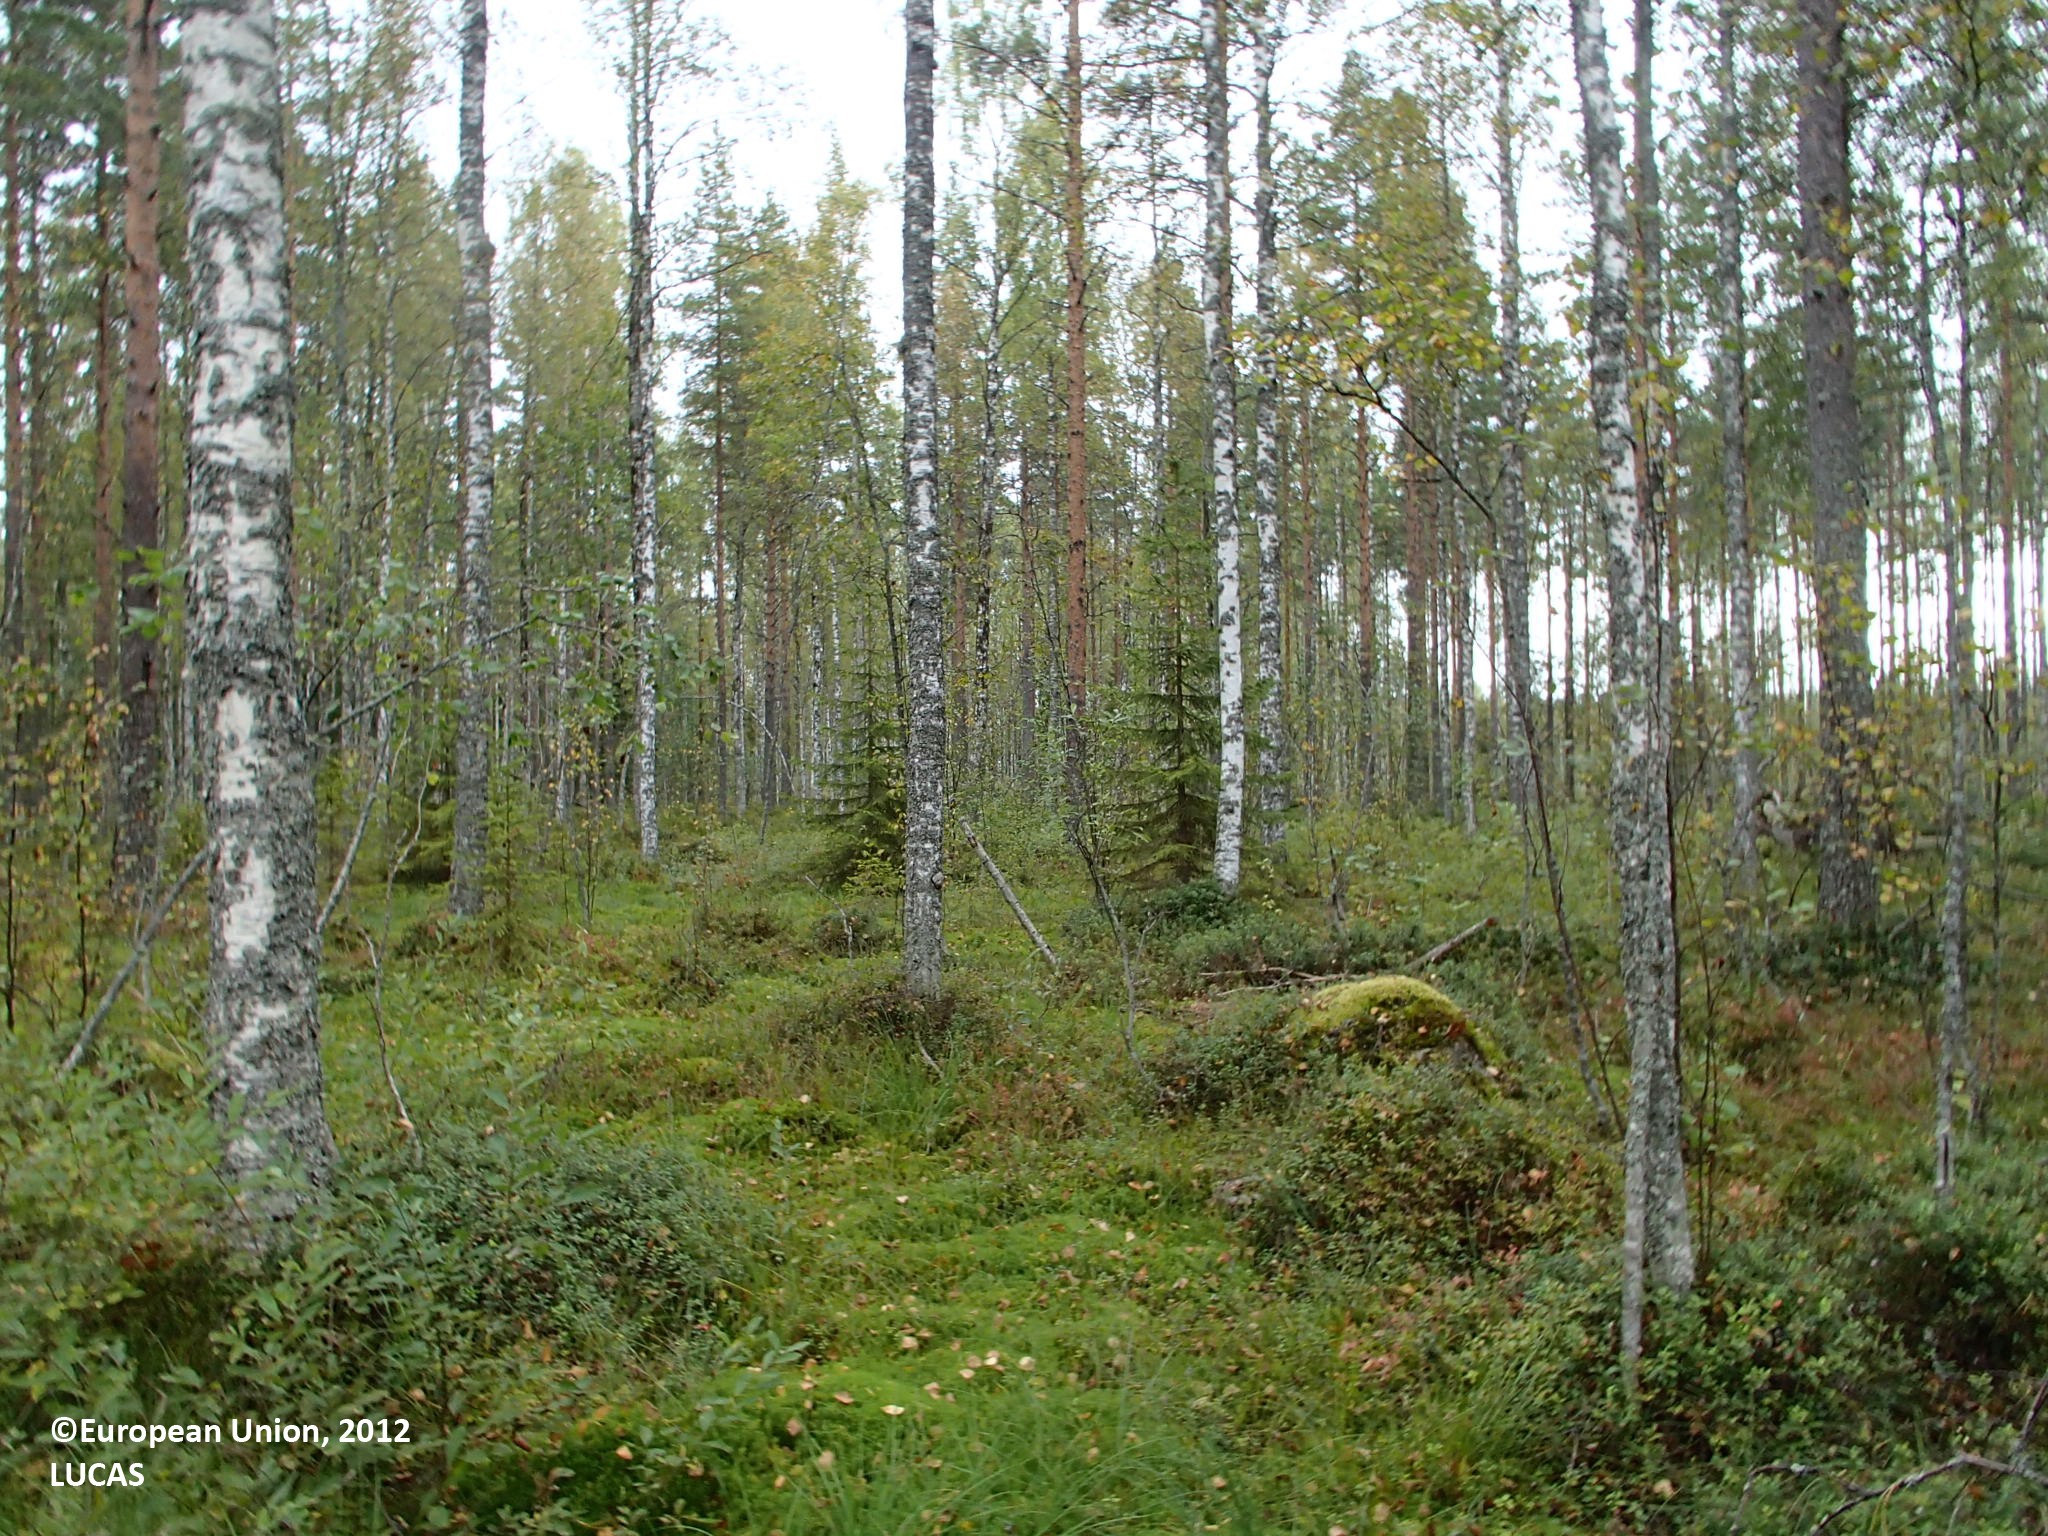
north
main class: Woodland
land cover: Pine dominated mixed woodland
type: boreal forest
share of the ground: 50 - 75 %
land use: Forestry
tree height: > 5 m
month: September
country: FI
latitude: 63.8481
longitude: 26.0749
